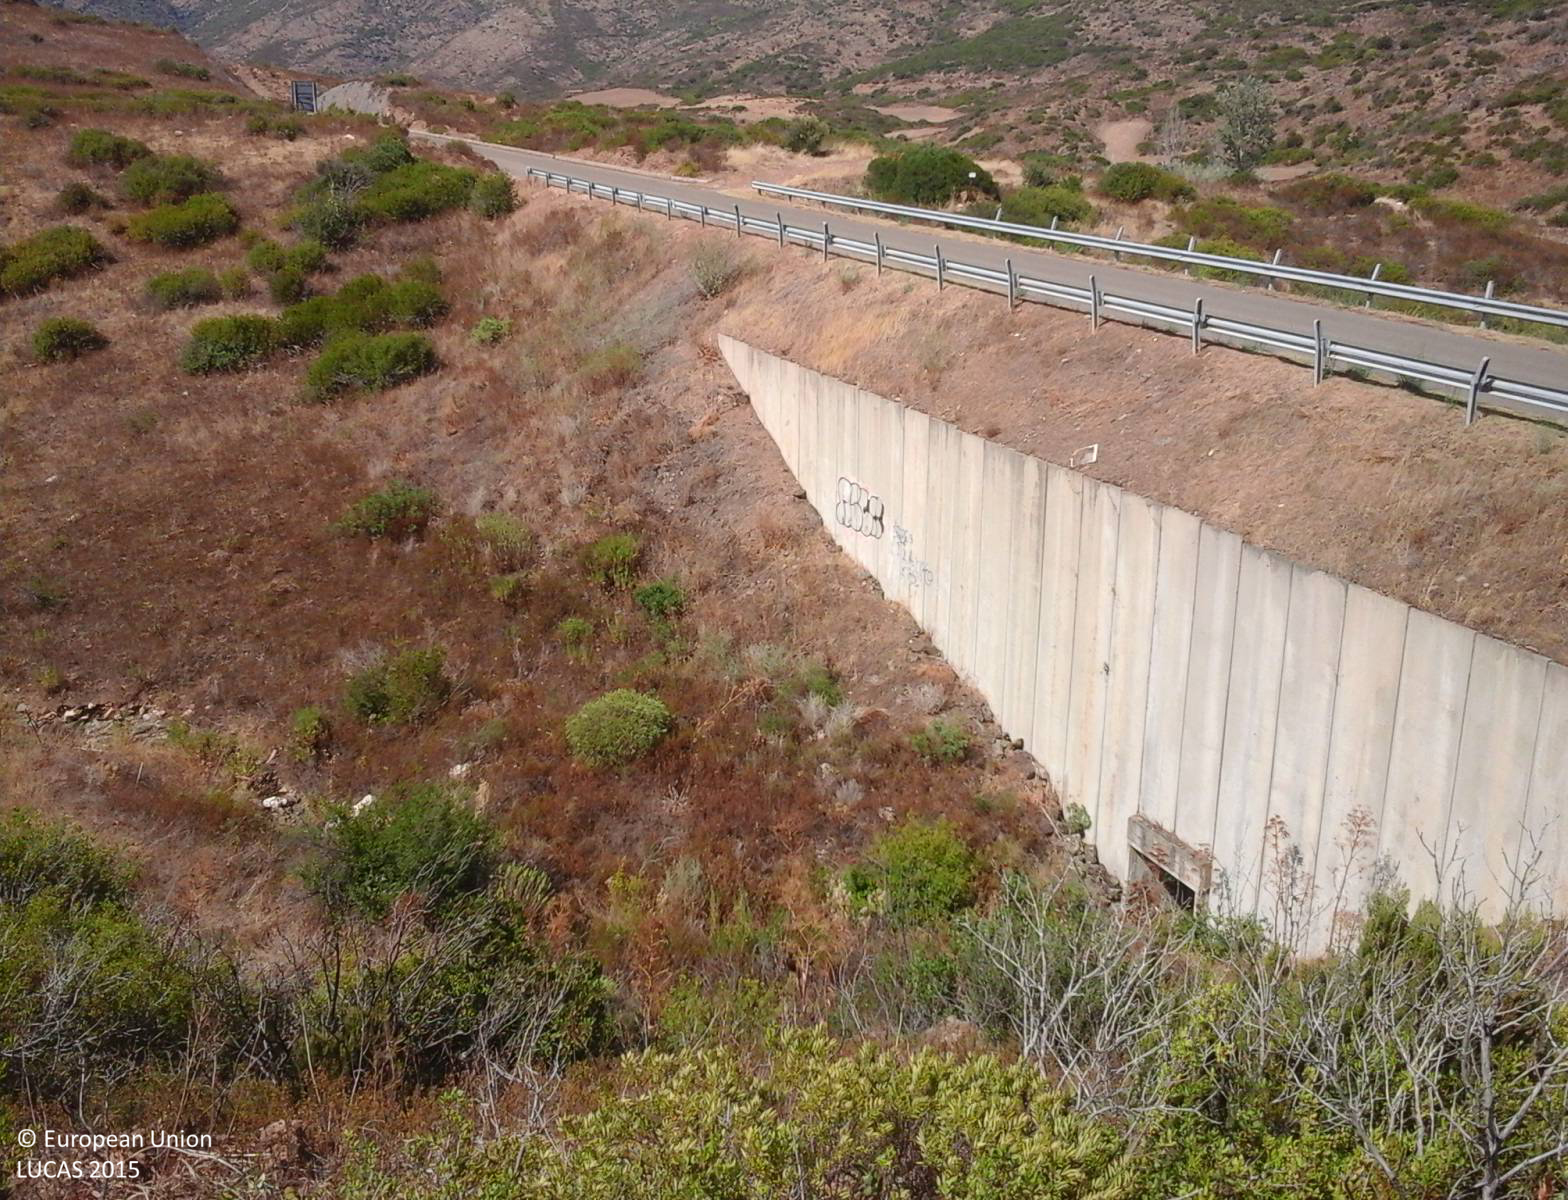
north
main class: Shrubland
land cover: Shrubland without tree cover
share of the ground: > 75 %
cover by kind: shrubs 100 %
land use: Agriculture (excluding fallow land and kitchen gardens)
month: August
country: IT
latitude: 39.3343
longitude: 8.6508
